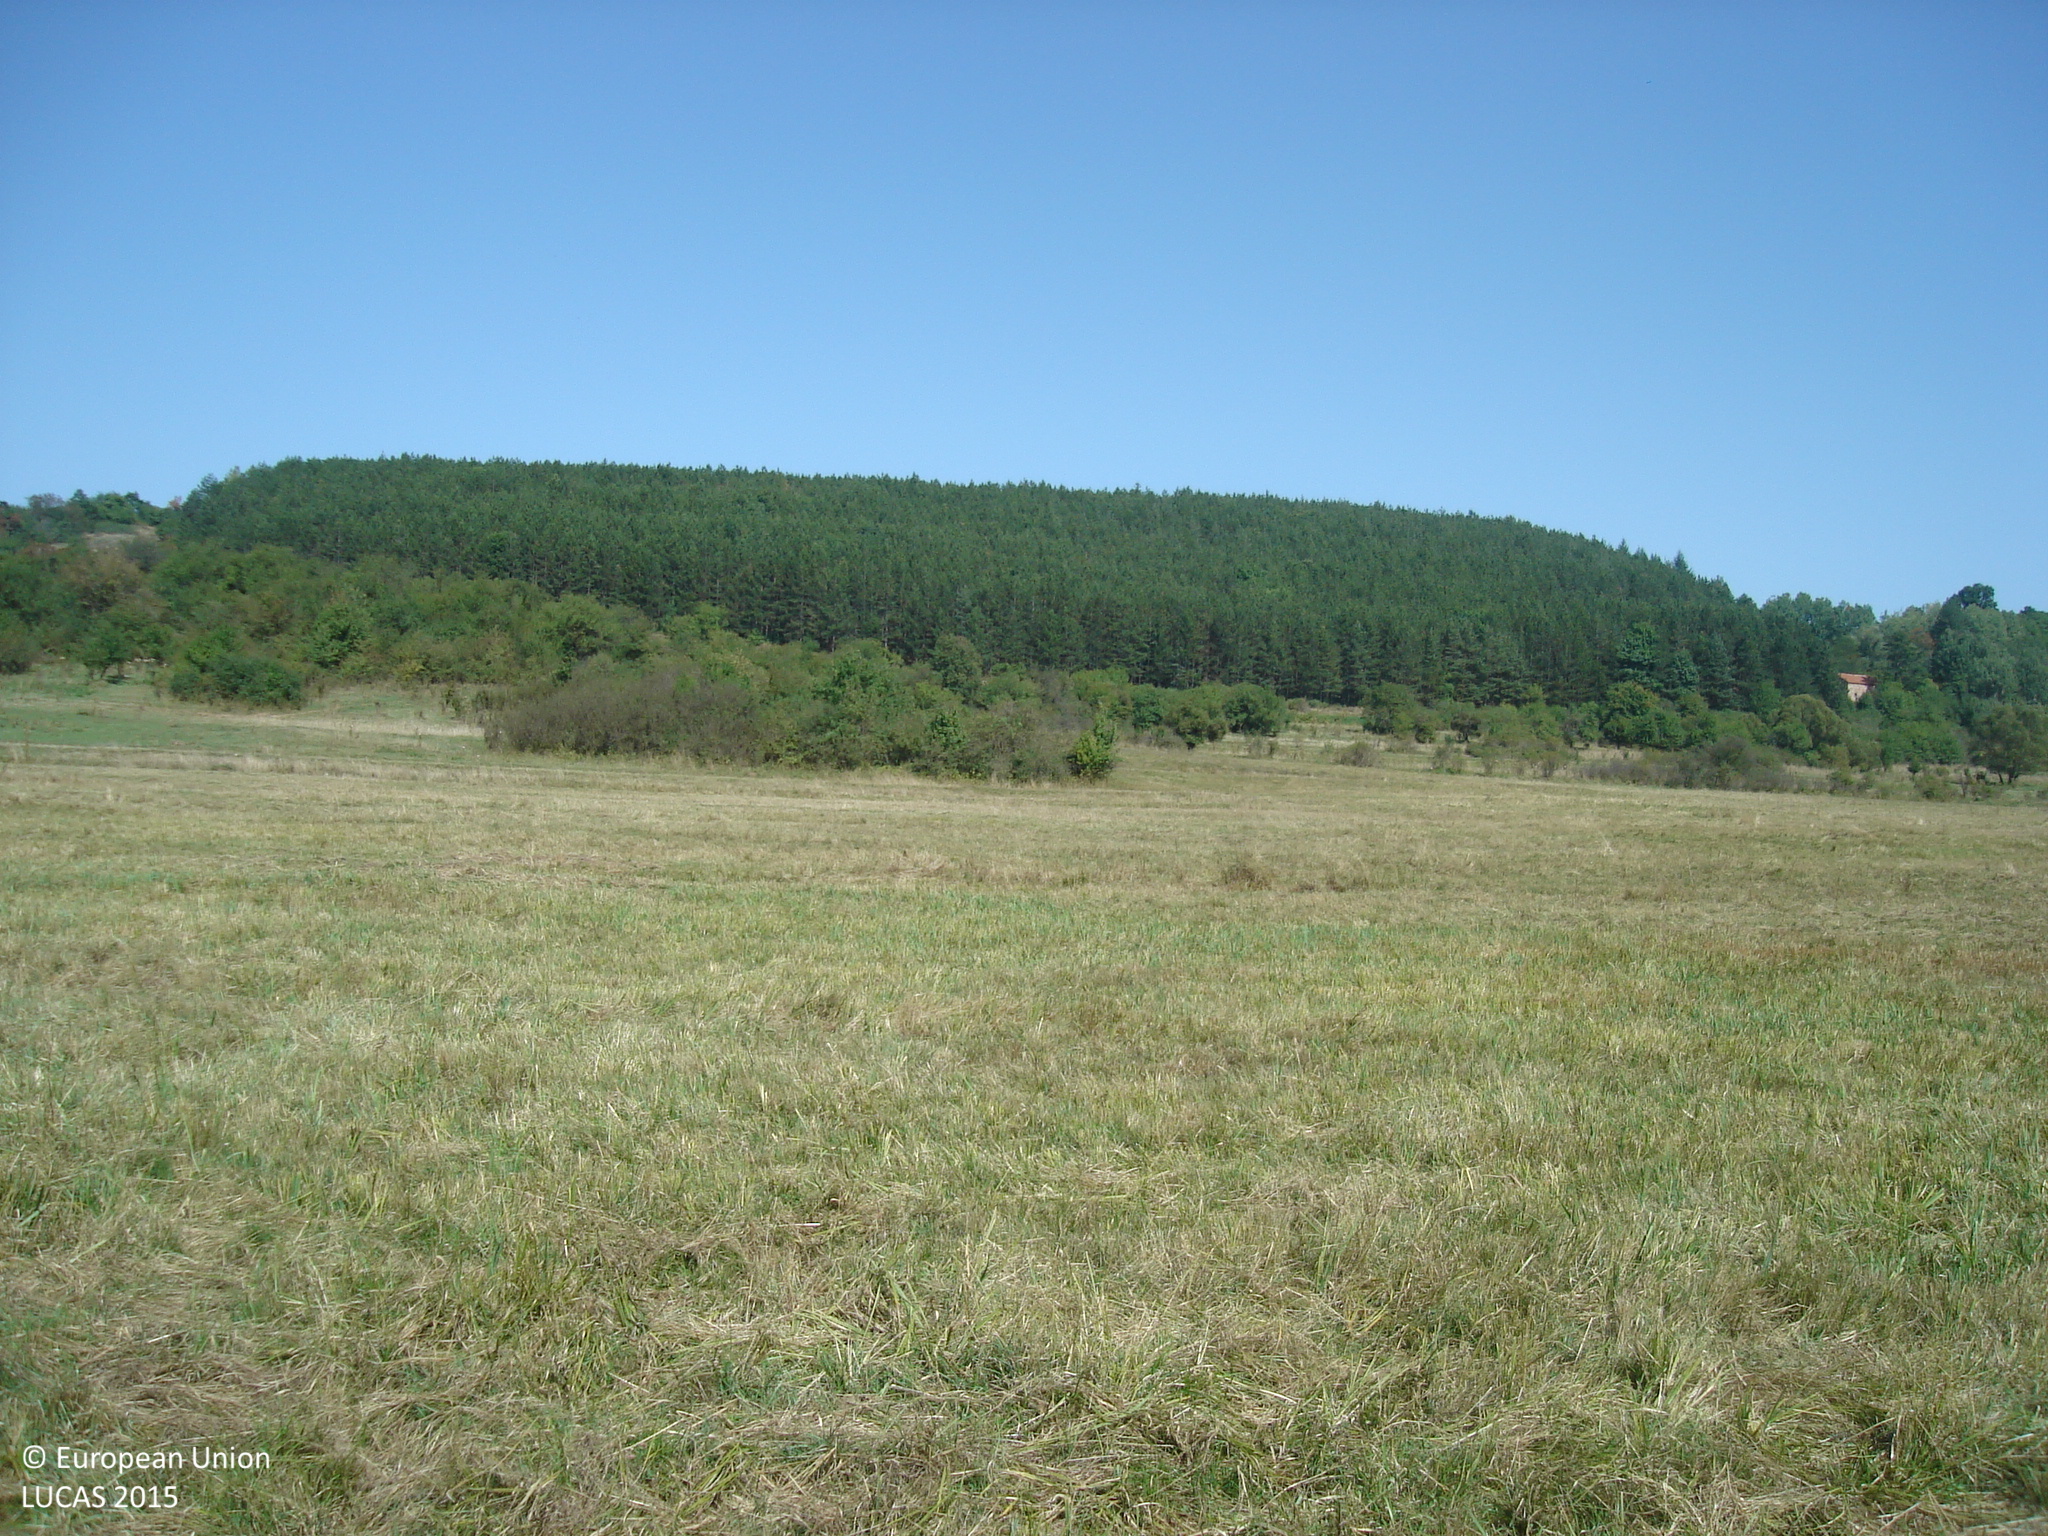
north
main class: Grassland
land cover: Grassland without tree/shrub cover
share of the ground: > 75 %
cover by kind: herbaceous plants 100 %
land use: Agriculture (excluding fallow land and kitchen gardens)
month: September
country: BG
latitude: 42.9485
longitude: 23.1114
